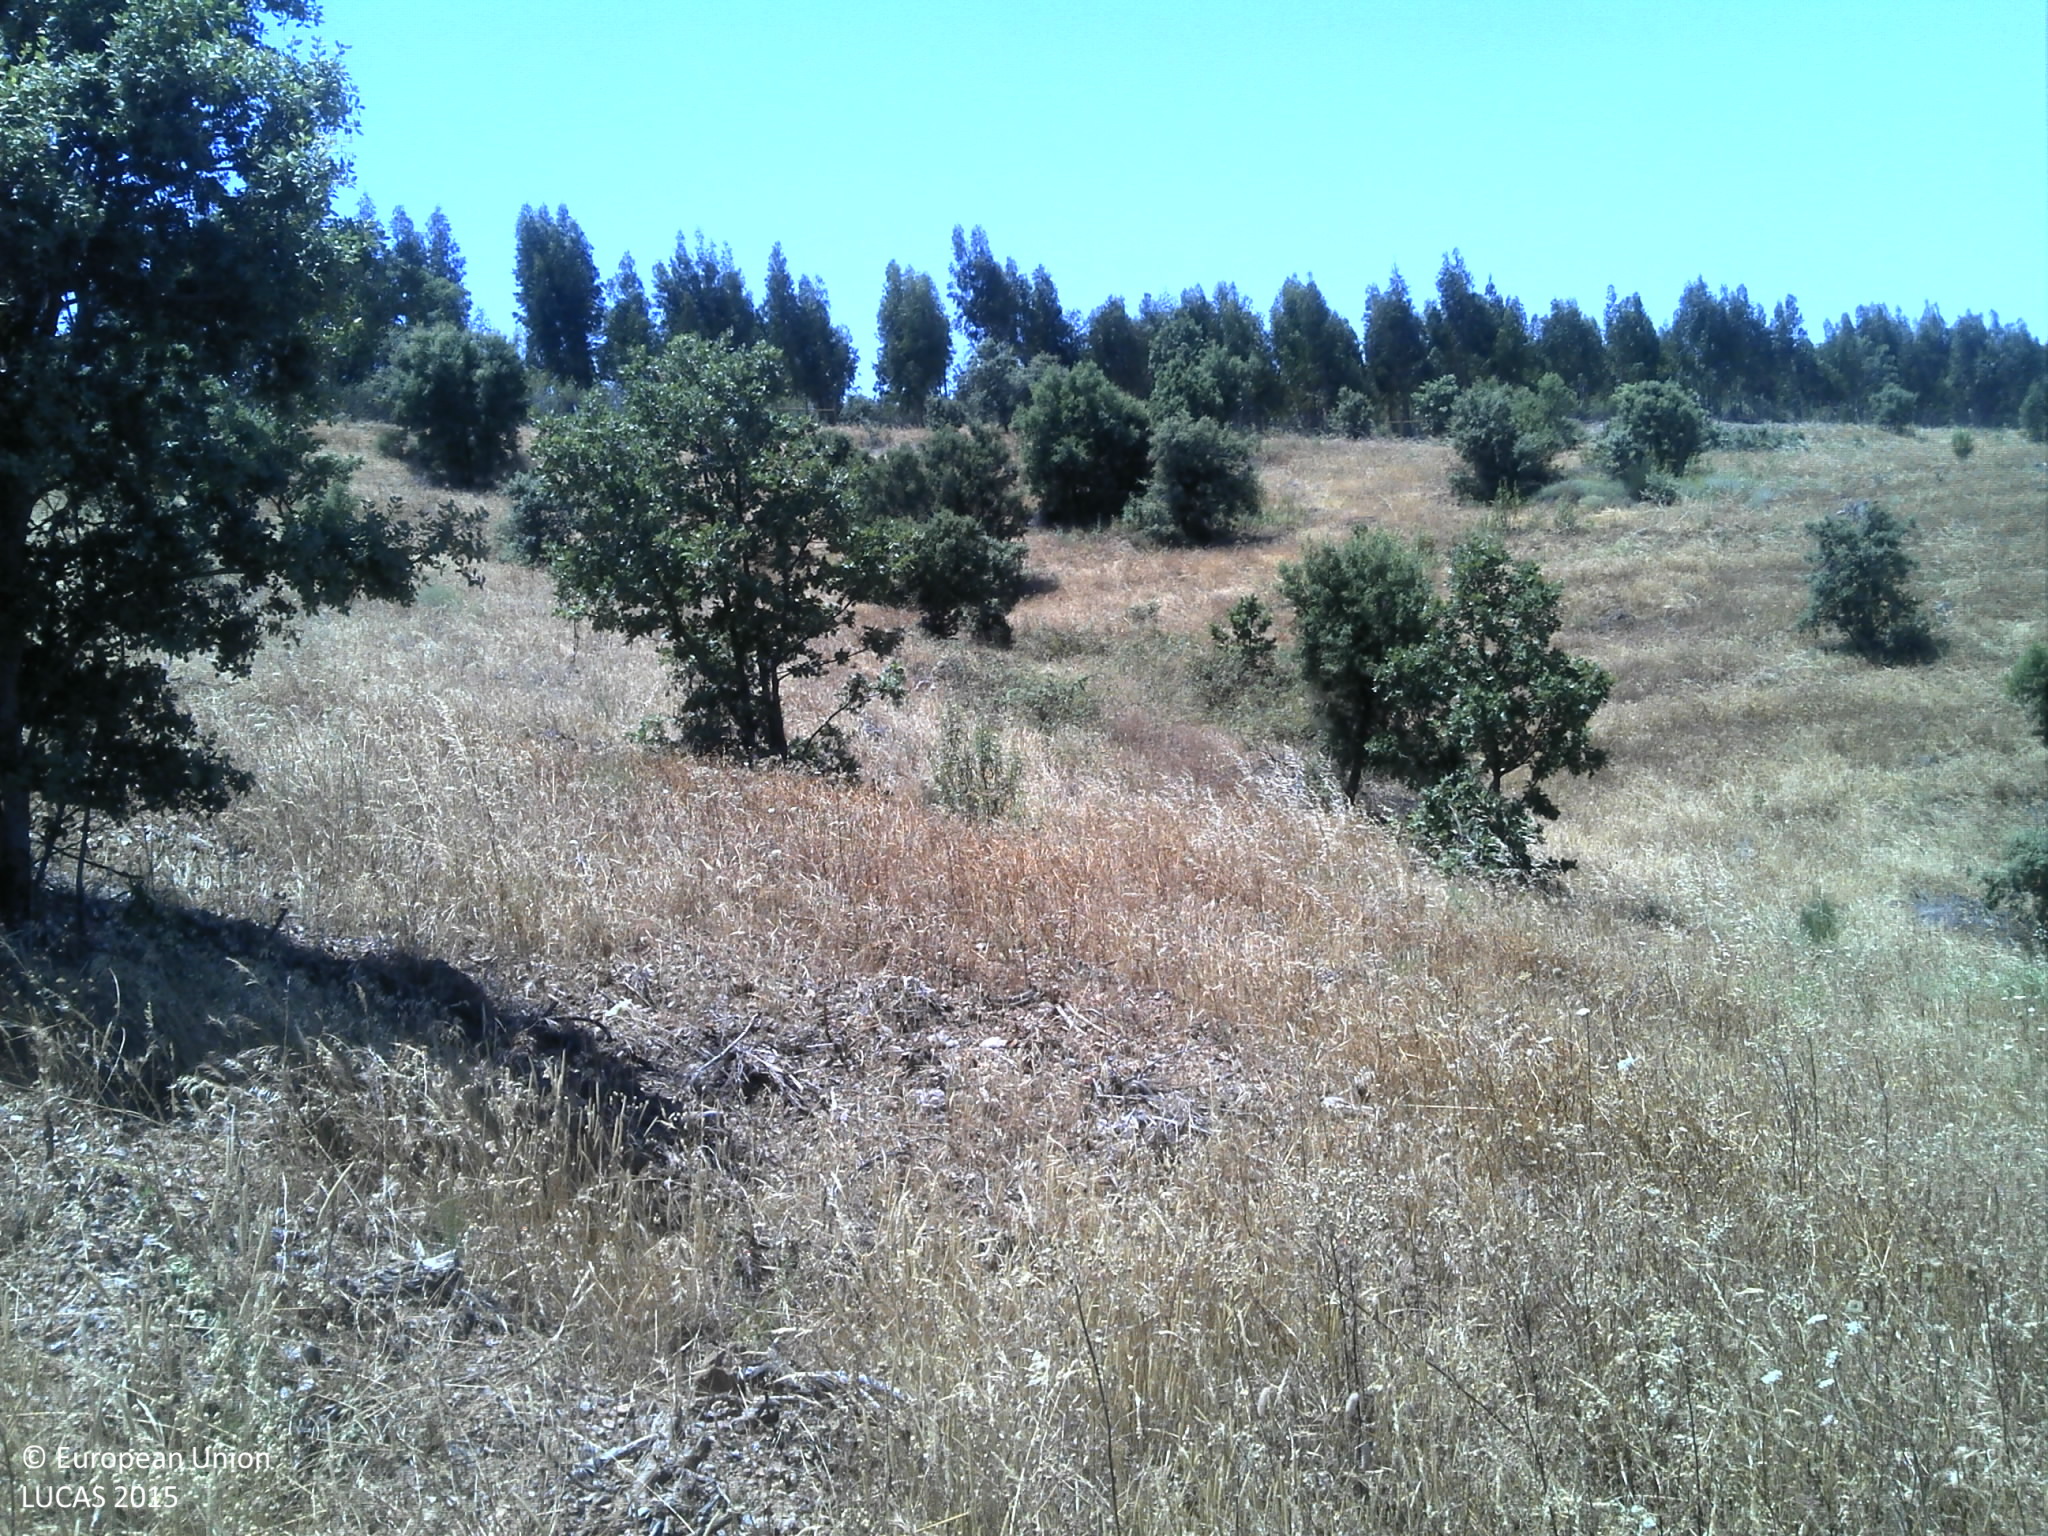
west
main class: Grassland
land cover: Grassland with sparse tree/shrub cover
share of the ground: 50 - 75 %
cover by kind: herbaceous plants 60 %, unconsolidated bare surface 20 %, broadleaved forest trees 5 %, shrubs 5 %
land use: Agriculture (excluding fallow land and kitchen gardens)
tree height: > 5 m
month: June
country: PT
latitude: 39.9848
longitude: -7.2282
